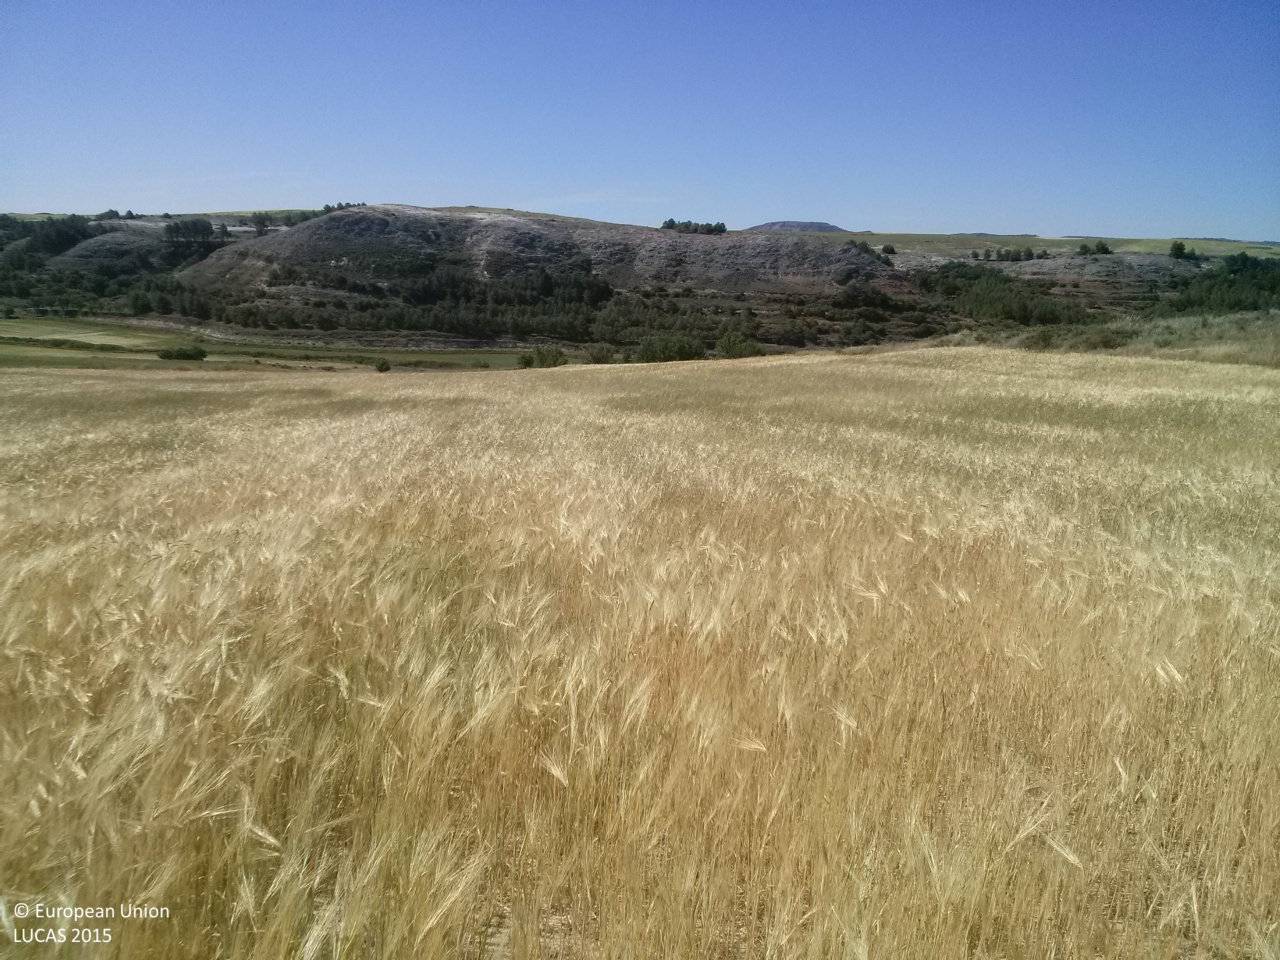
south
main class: Cropland
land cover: Barley
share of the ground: > 75 %
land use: Agriculture (excluding fallow land and kitchen gardens)
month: May
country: ES
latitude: 40.3285
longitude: -2.6054
